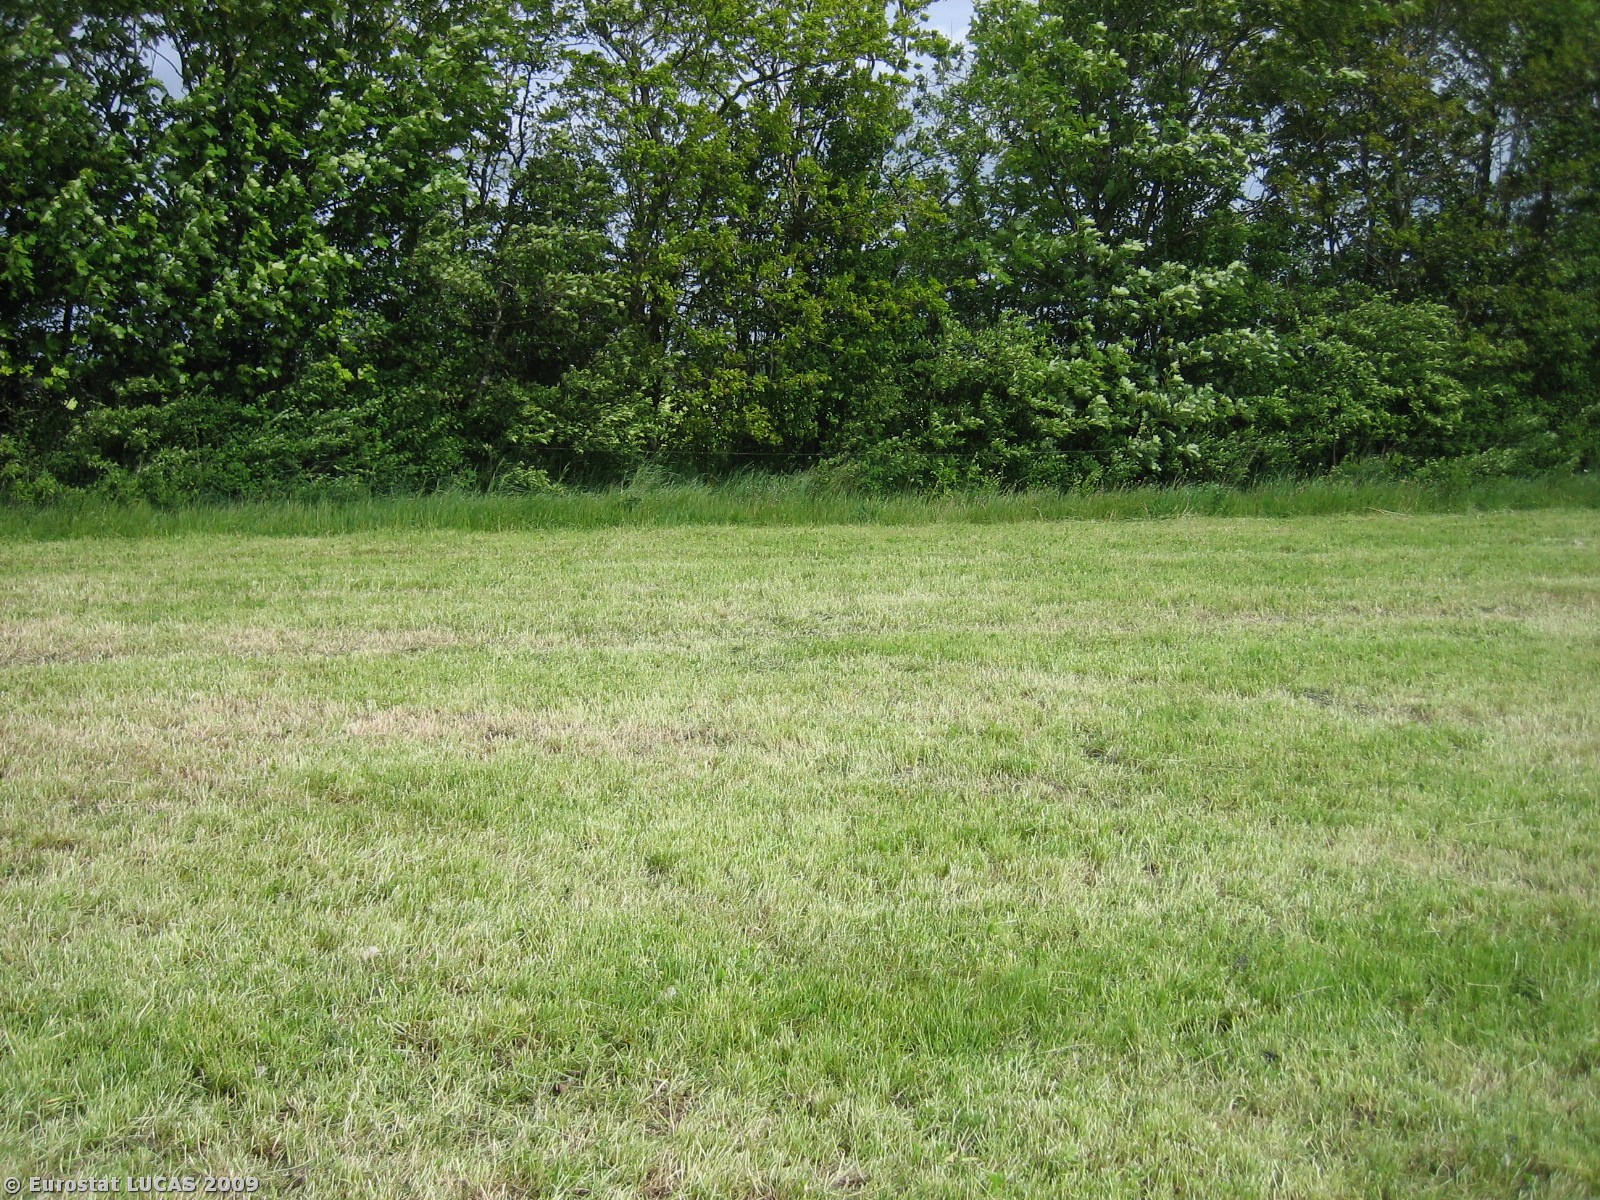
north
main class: Grassland
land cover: Grassland without tree/shrub cover
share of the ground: > 75 %
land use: Agriculture (excluding fallow land and kitchen gardens)
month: May
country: DK
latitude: 56.0745
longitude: 8.8285
